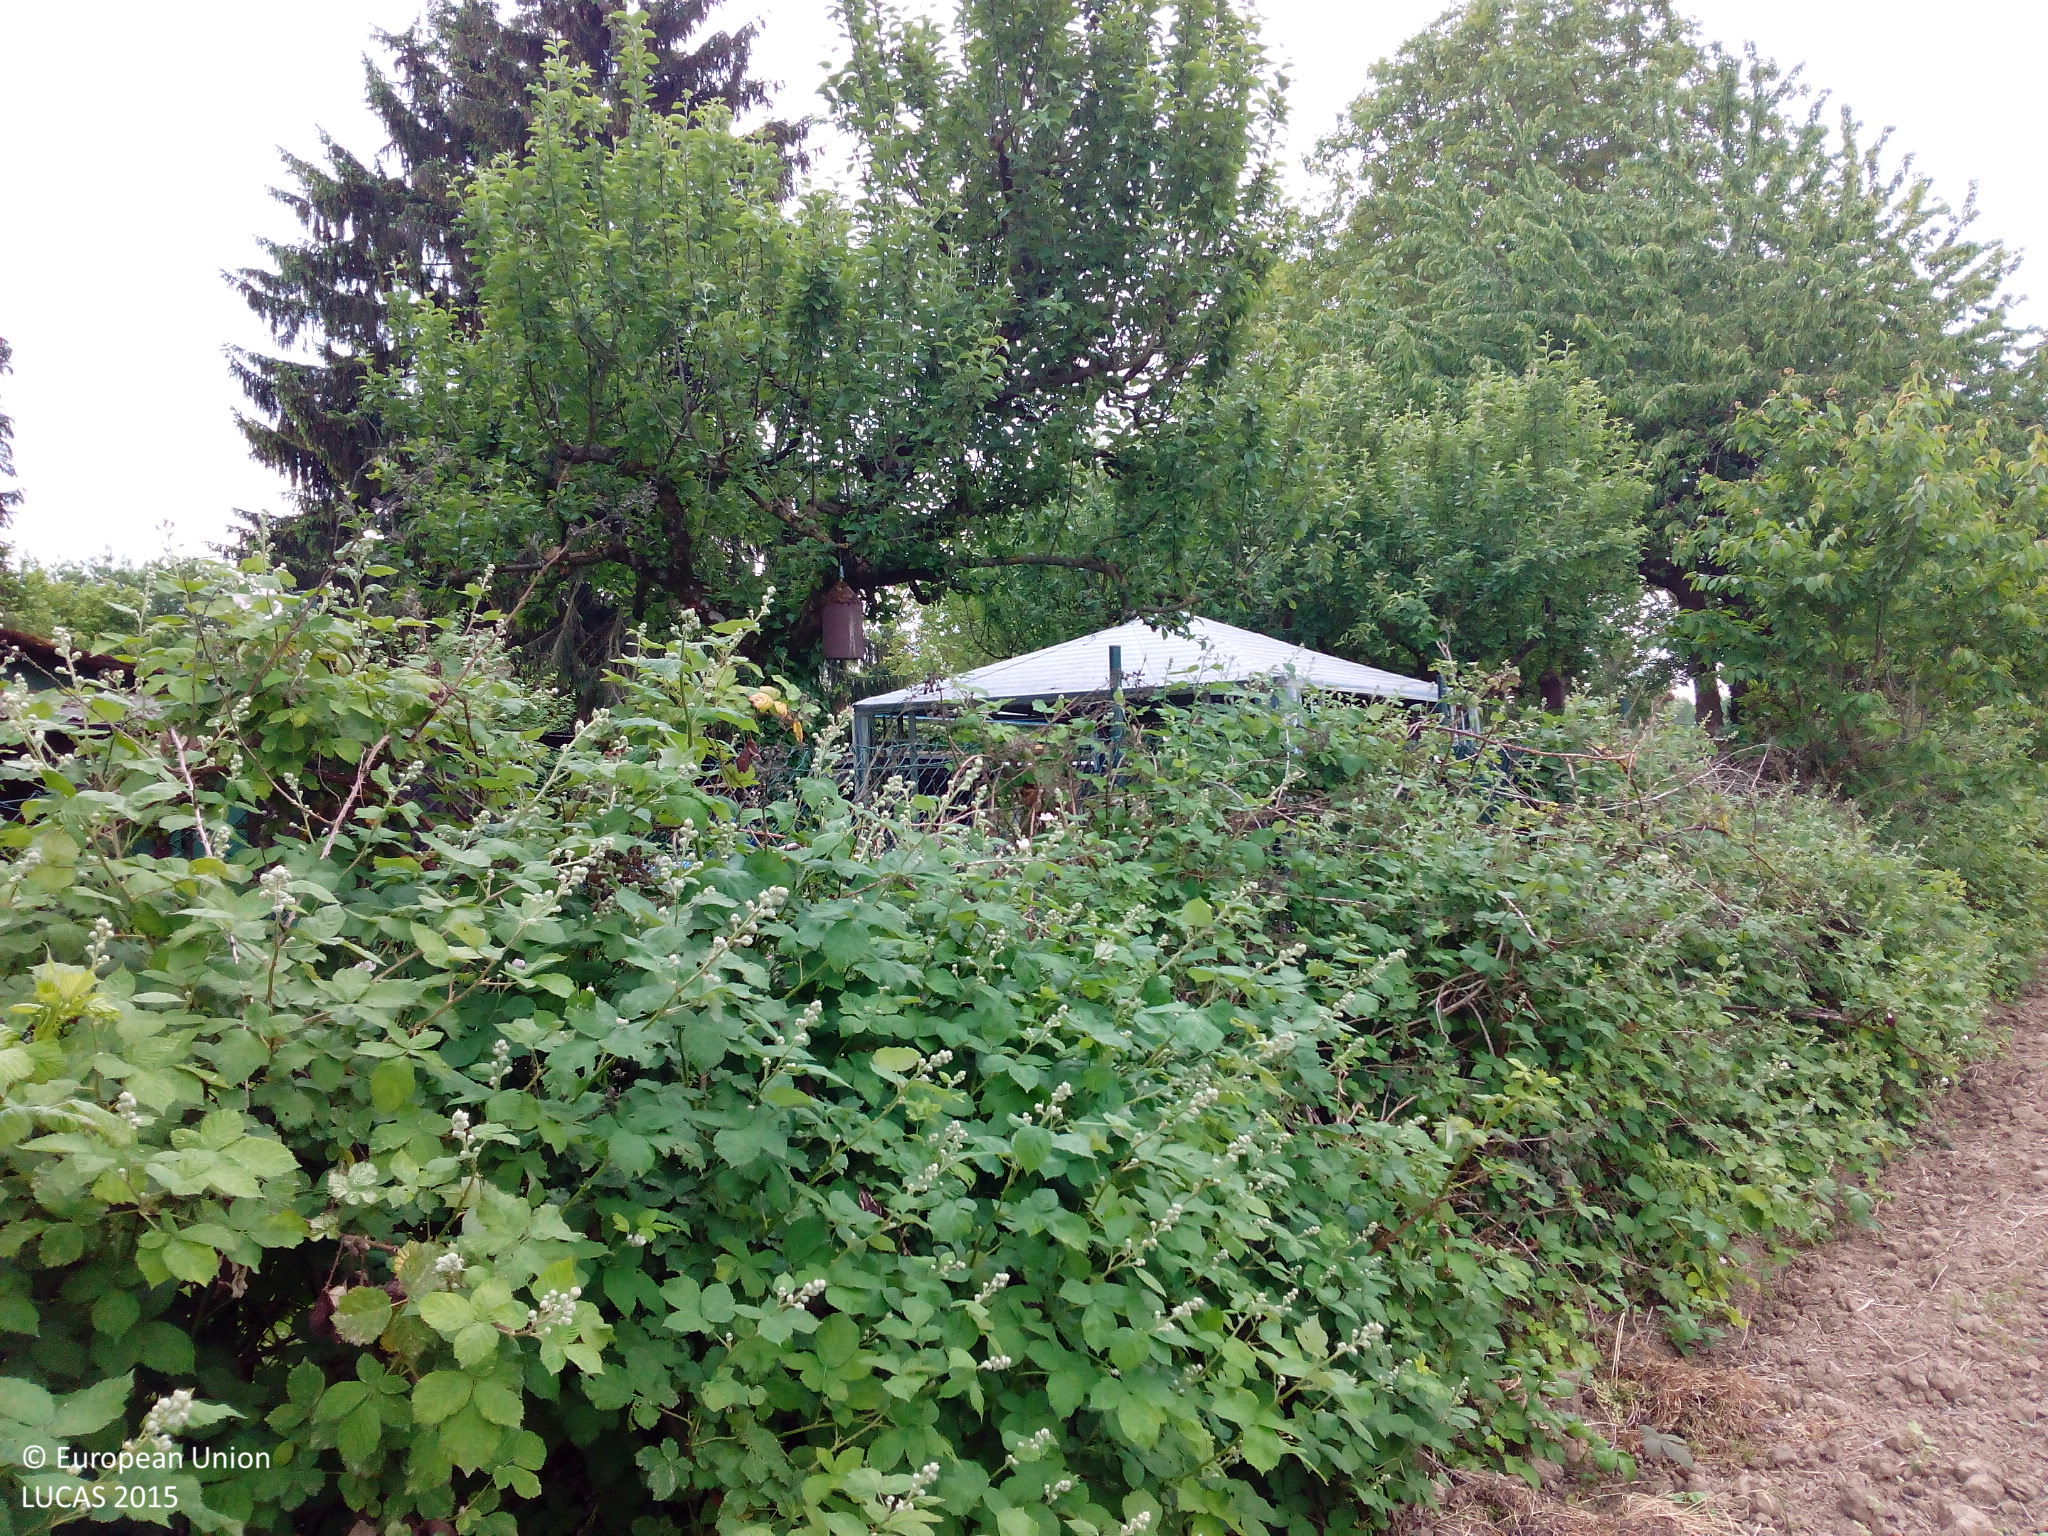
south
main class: Cropland
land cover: Other cereals
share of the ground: 10 - 25 %
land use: Agriculture (excluding fallow land and kitchen gardens)
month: May
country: DE
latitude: 48.8565
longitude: 8.1879
